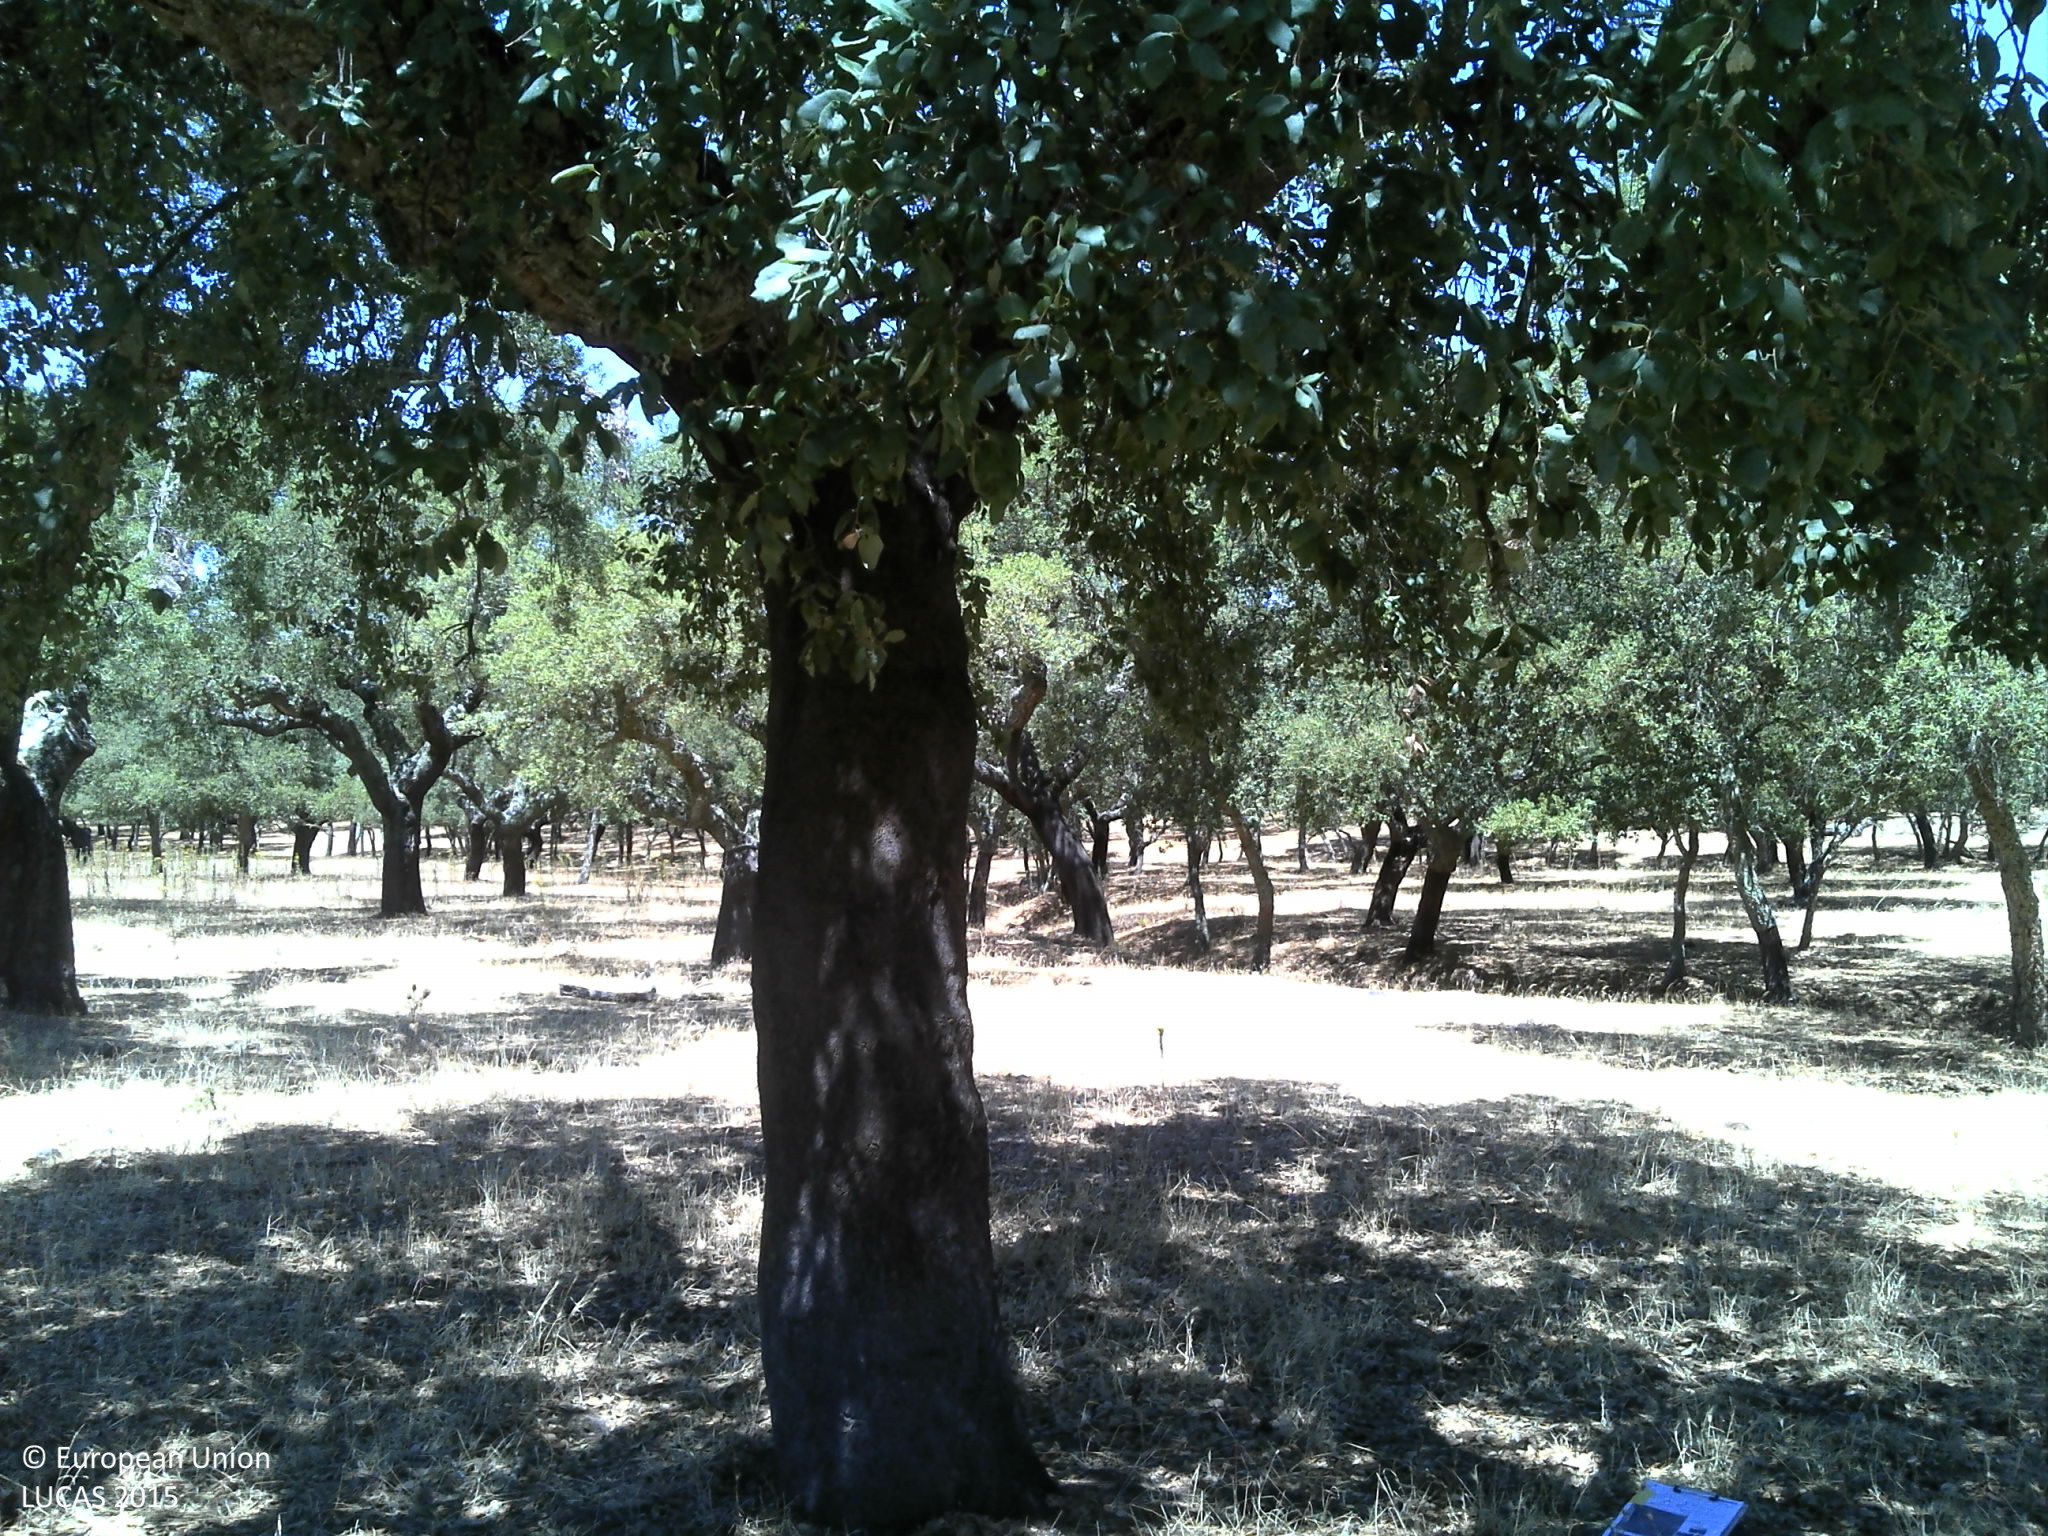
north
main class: Woodland
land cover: Broadleaved woodland
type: broadleaved evergreen forest
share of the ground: 50 - 75 %
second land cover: Grassland without tree/shrub cover
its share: 10 - 25 %
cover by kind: broadleaved forest trees 50 %, unconsolidated bare surface 30 %, herbaceous plants 20 %
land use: Forestry
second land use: Agriculture (excluding fallow land and kitchen gardens)
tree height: > 5 m
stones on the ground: < 10 %
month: July
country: PT
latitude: 38.8578
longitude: -7.5405
